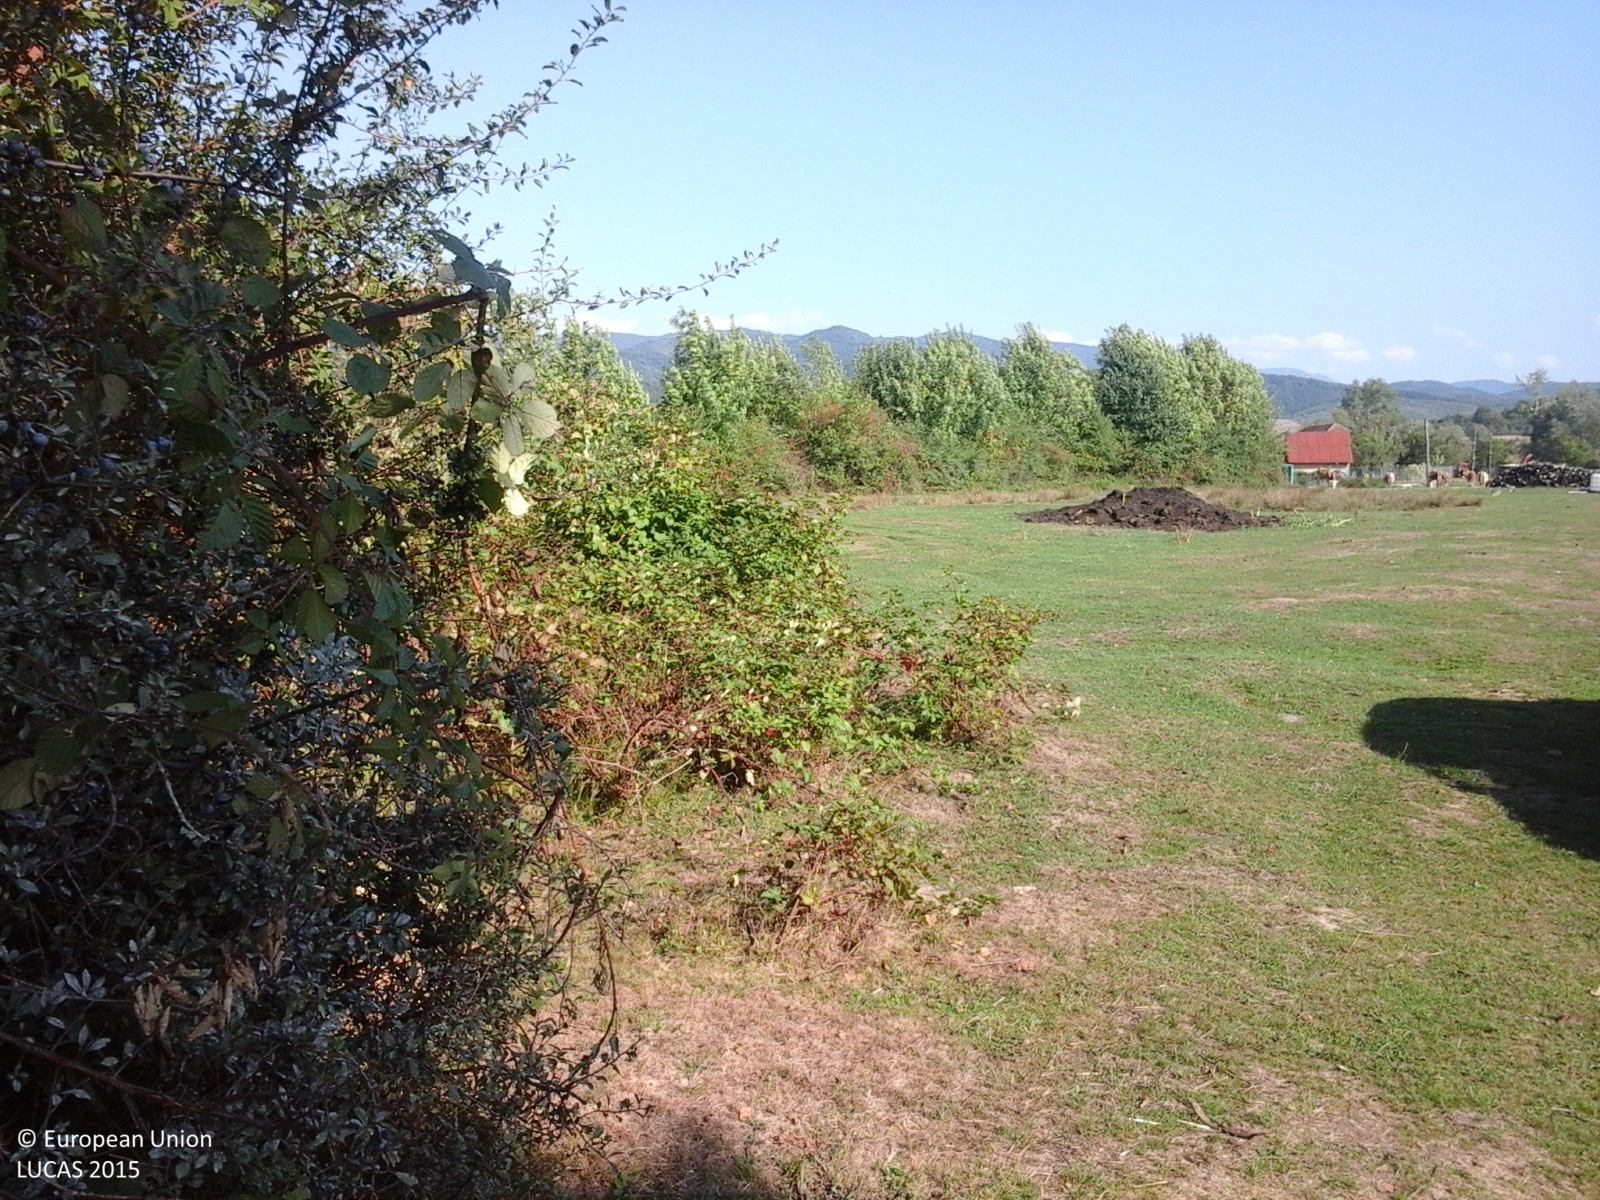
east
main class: Grassland
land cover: Grassland without tree/shrub cover
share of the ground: > 75 %
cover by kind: herbaceous plants 100 %
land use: Agriculture (excluding fallow land and kitchen gardens)
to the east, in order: Grassland without tree/shrub cover; Maize; Grassland without tree/shrub cover; Fences; Abandoned hedges; Grassland without tree/shrub cover; Abandoned hedges; Grassland without tree/shrub cover; Maize; Grassland without tree/shrub cover; Maize; Grassland without tree/shrub cover
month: September
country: RO
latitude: 46.7115
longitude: 22.4660
